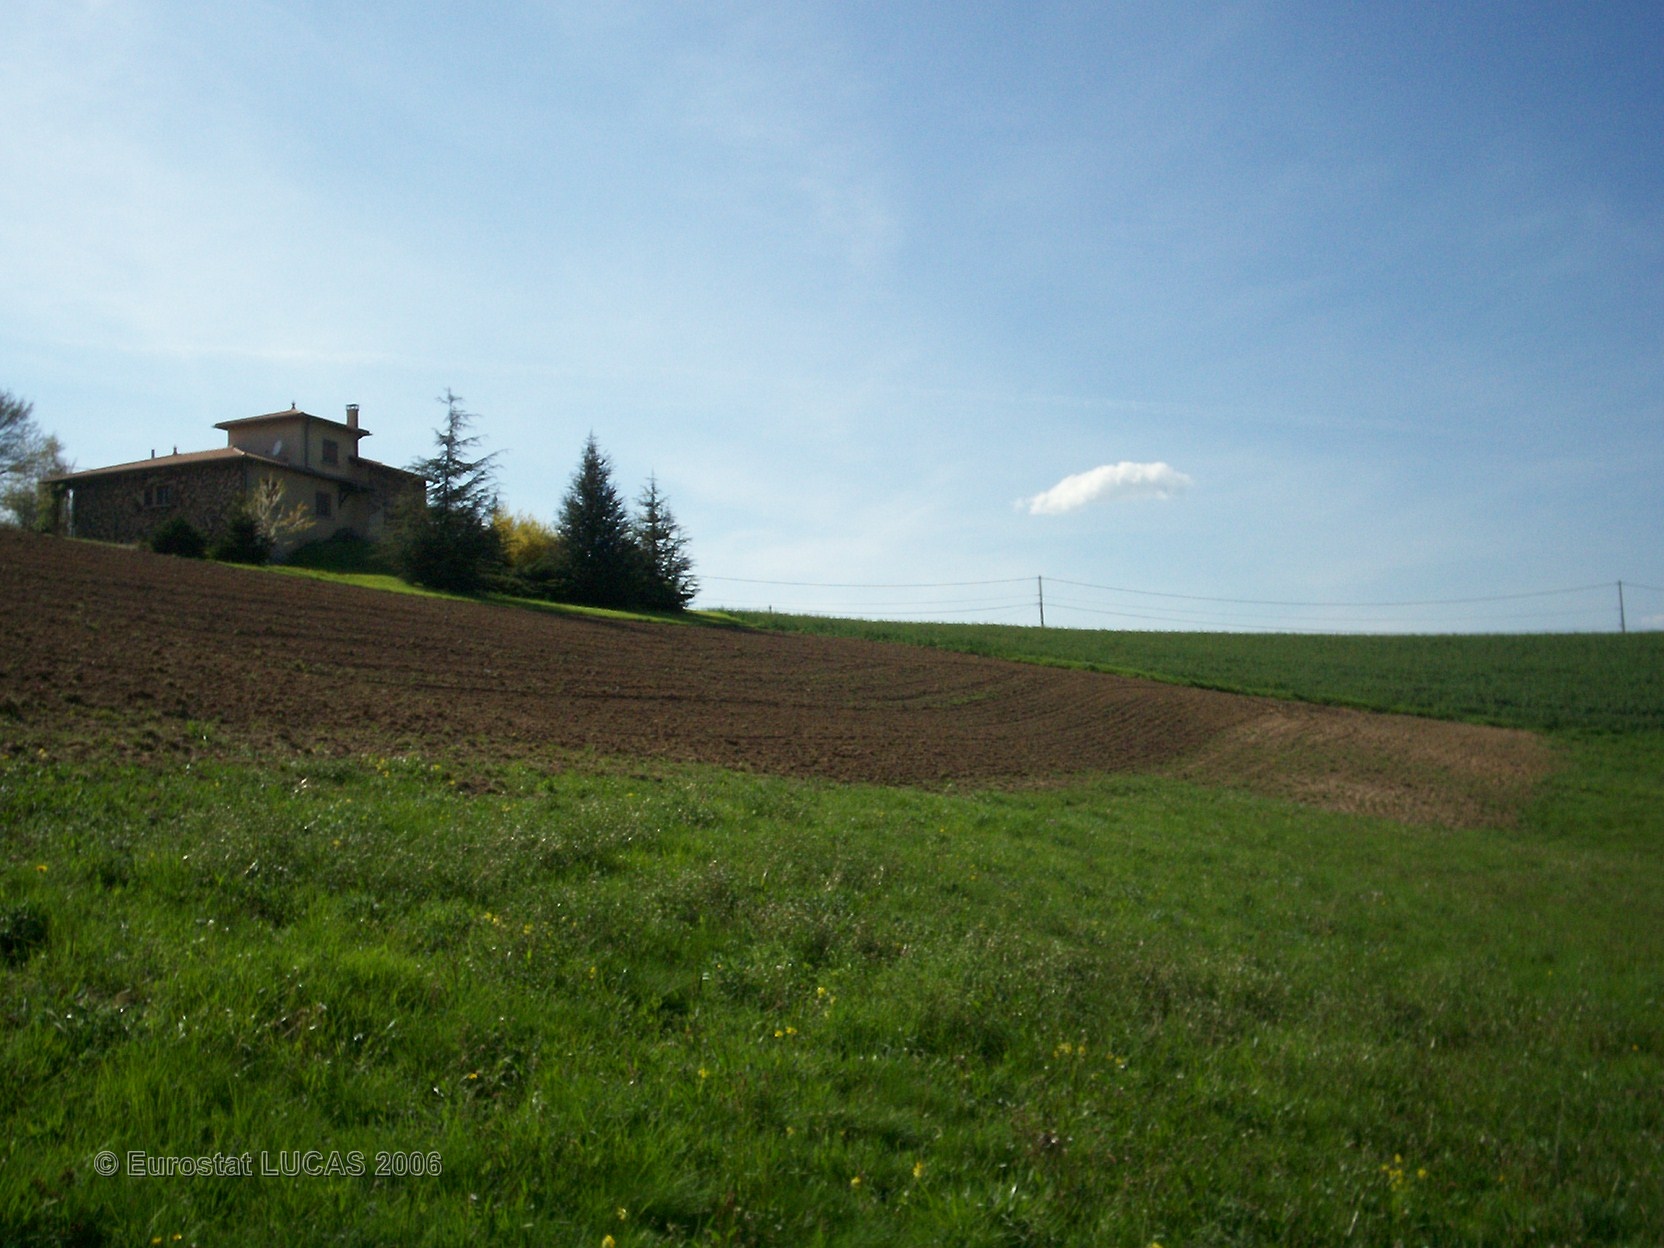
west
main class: Grassland
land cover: Grassland without tree/shrub cover
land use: Agriculture (excluding fallow land and kitchen gardens)
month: April
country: FR
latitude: 45.5384
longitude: 4.7919
